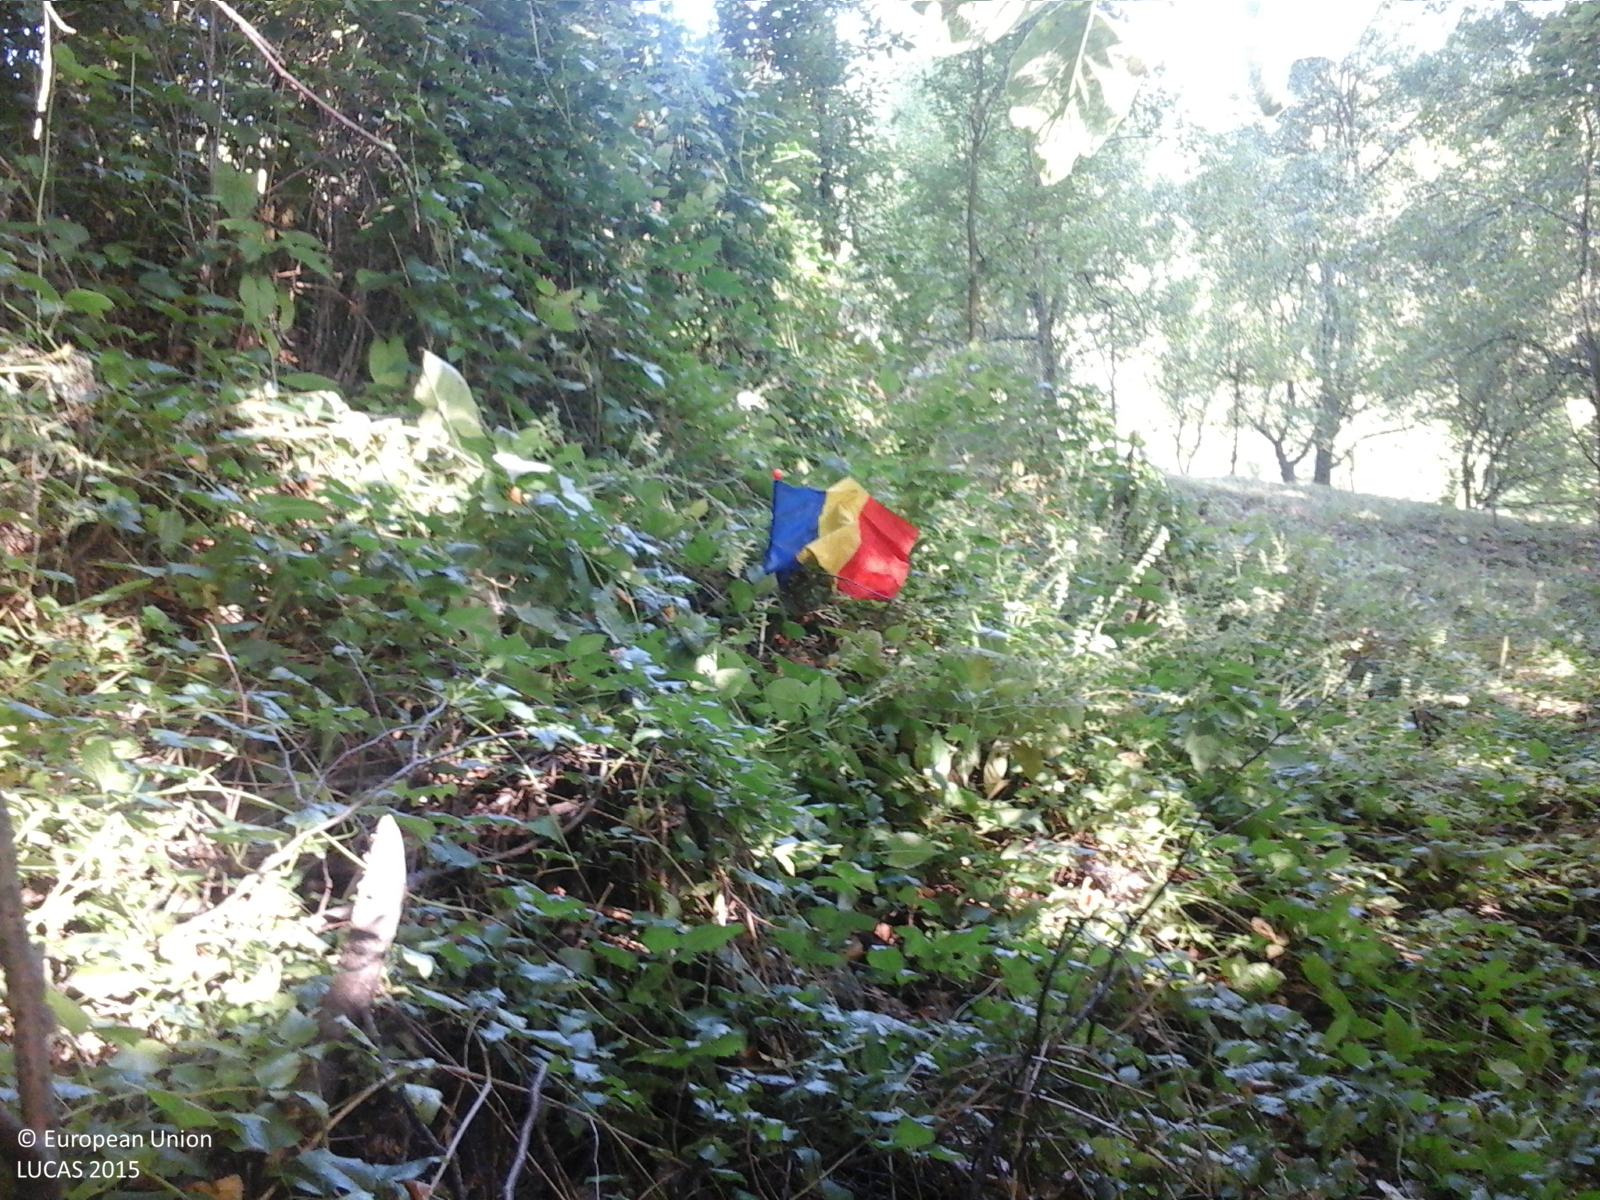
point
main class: Woodland
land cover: Broadleaved woodland
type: mesophytic deciduous forest
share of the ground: > 75 %
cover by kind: broadleaved forest trees 100 %
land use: Forestry
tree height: > 5 m
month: September
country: RO
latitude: 47.2900
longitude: 23.8438
